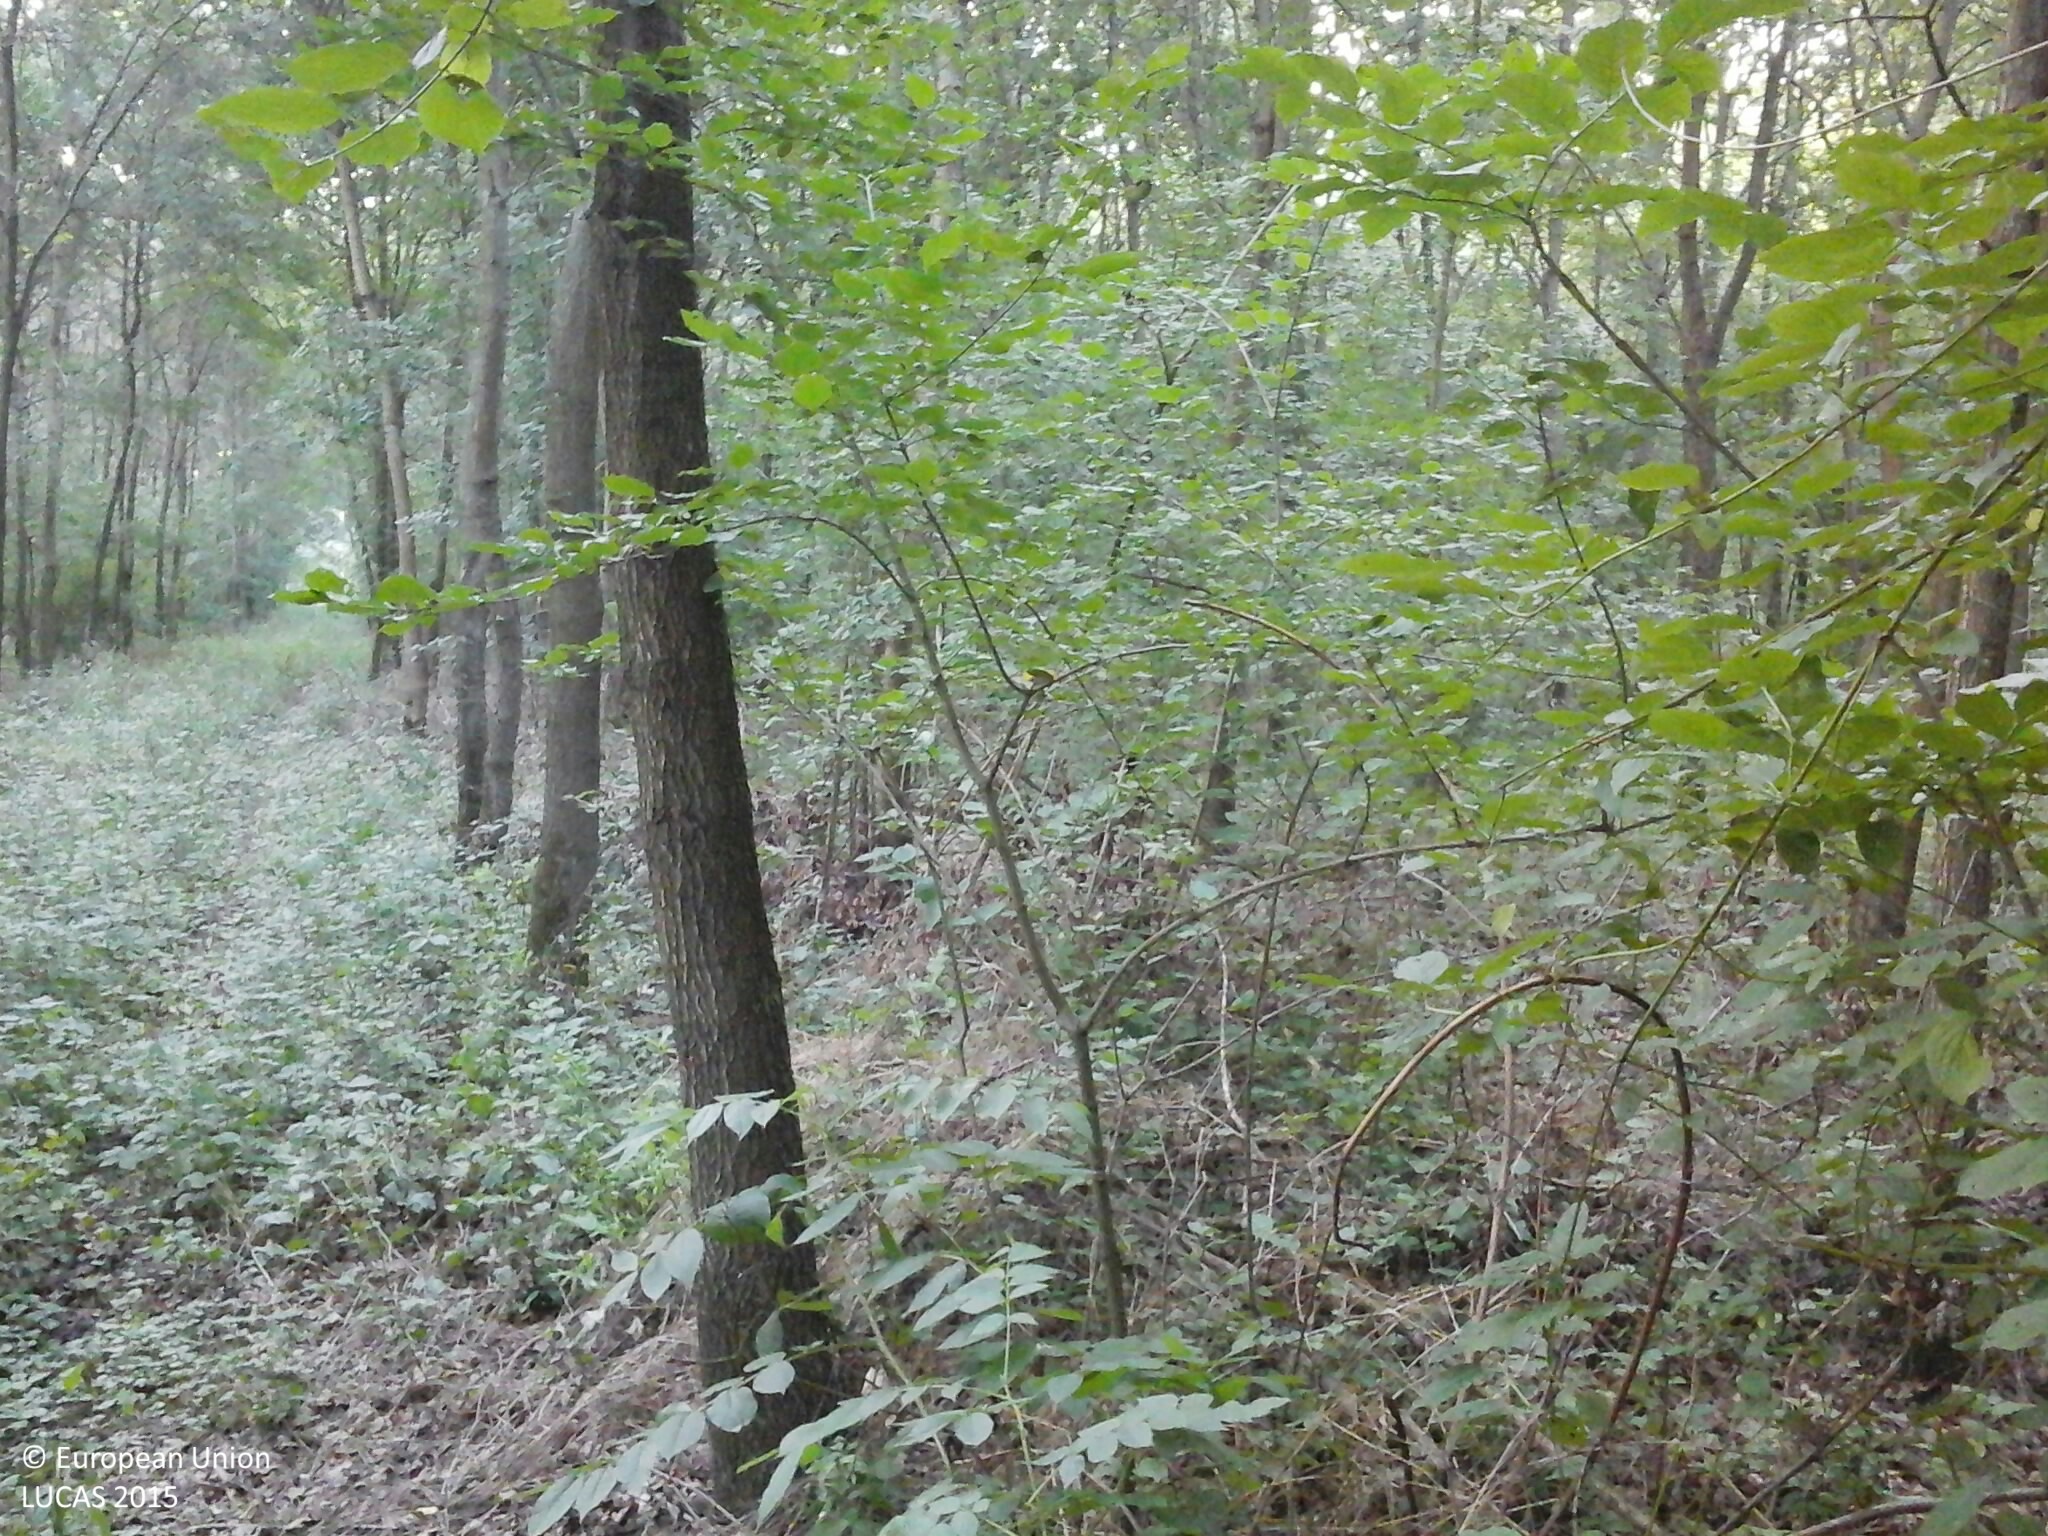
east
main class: Woodland
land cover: Broadleaved woodland
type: exotic forest
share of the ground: > 75 %
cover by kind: broadleaved forest trees 95 %, herbaceous plants 5 %
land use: Forestry
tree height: > 5 m
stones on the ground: < 10 %
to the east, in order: Broadleaved woodland; Tracks; Broadleaved woodland
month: July
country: HU
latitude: 48.1649
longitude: 22.3334
